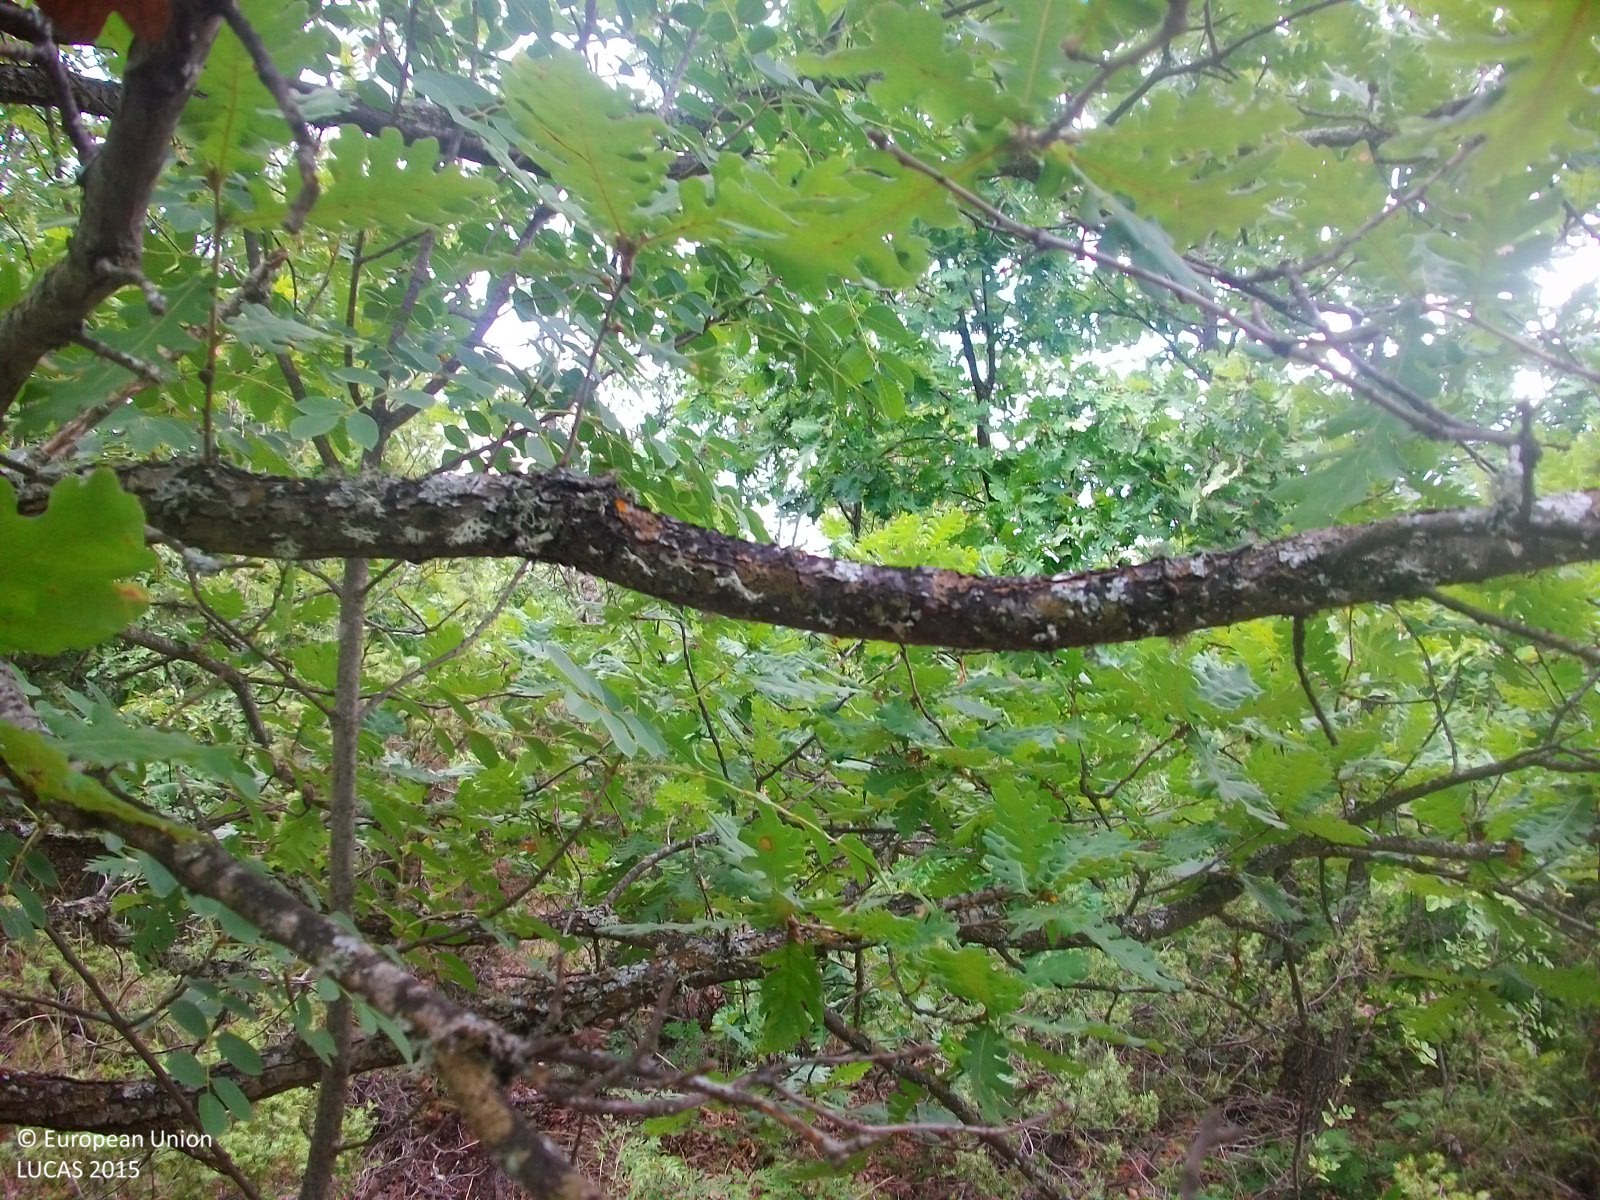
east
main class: Woodland
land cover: Broadleaved woodland
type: thermophilous deciduous forest
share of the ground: > 75 %
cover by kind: broadleaved forest trees 90 %, herbaceous plants 10 %
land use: Forestry
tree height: > 5 m
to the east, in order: Broadleaved woodland
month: August
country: GR
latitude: 41.3374
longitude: 26.2140
